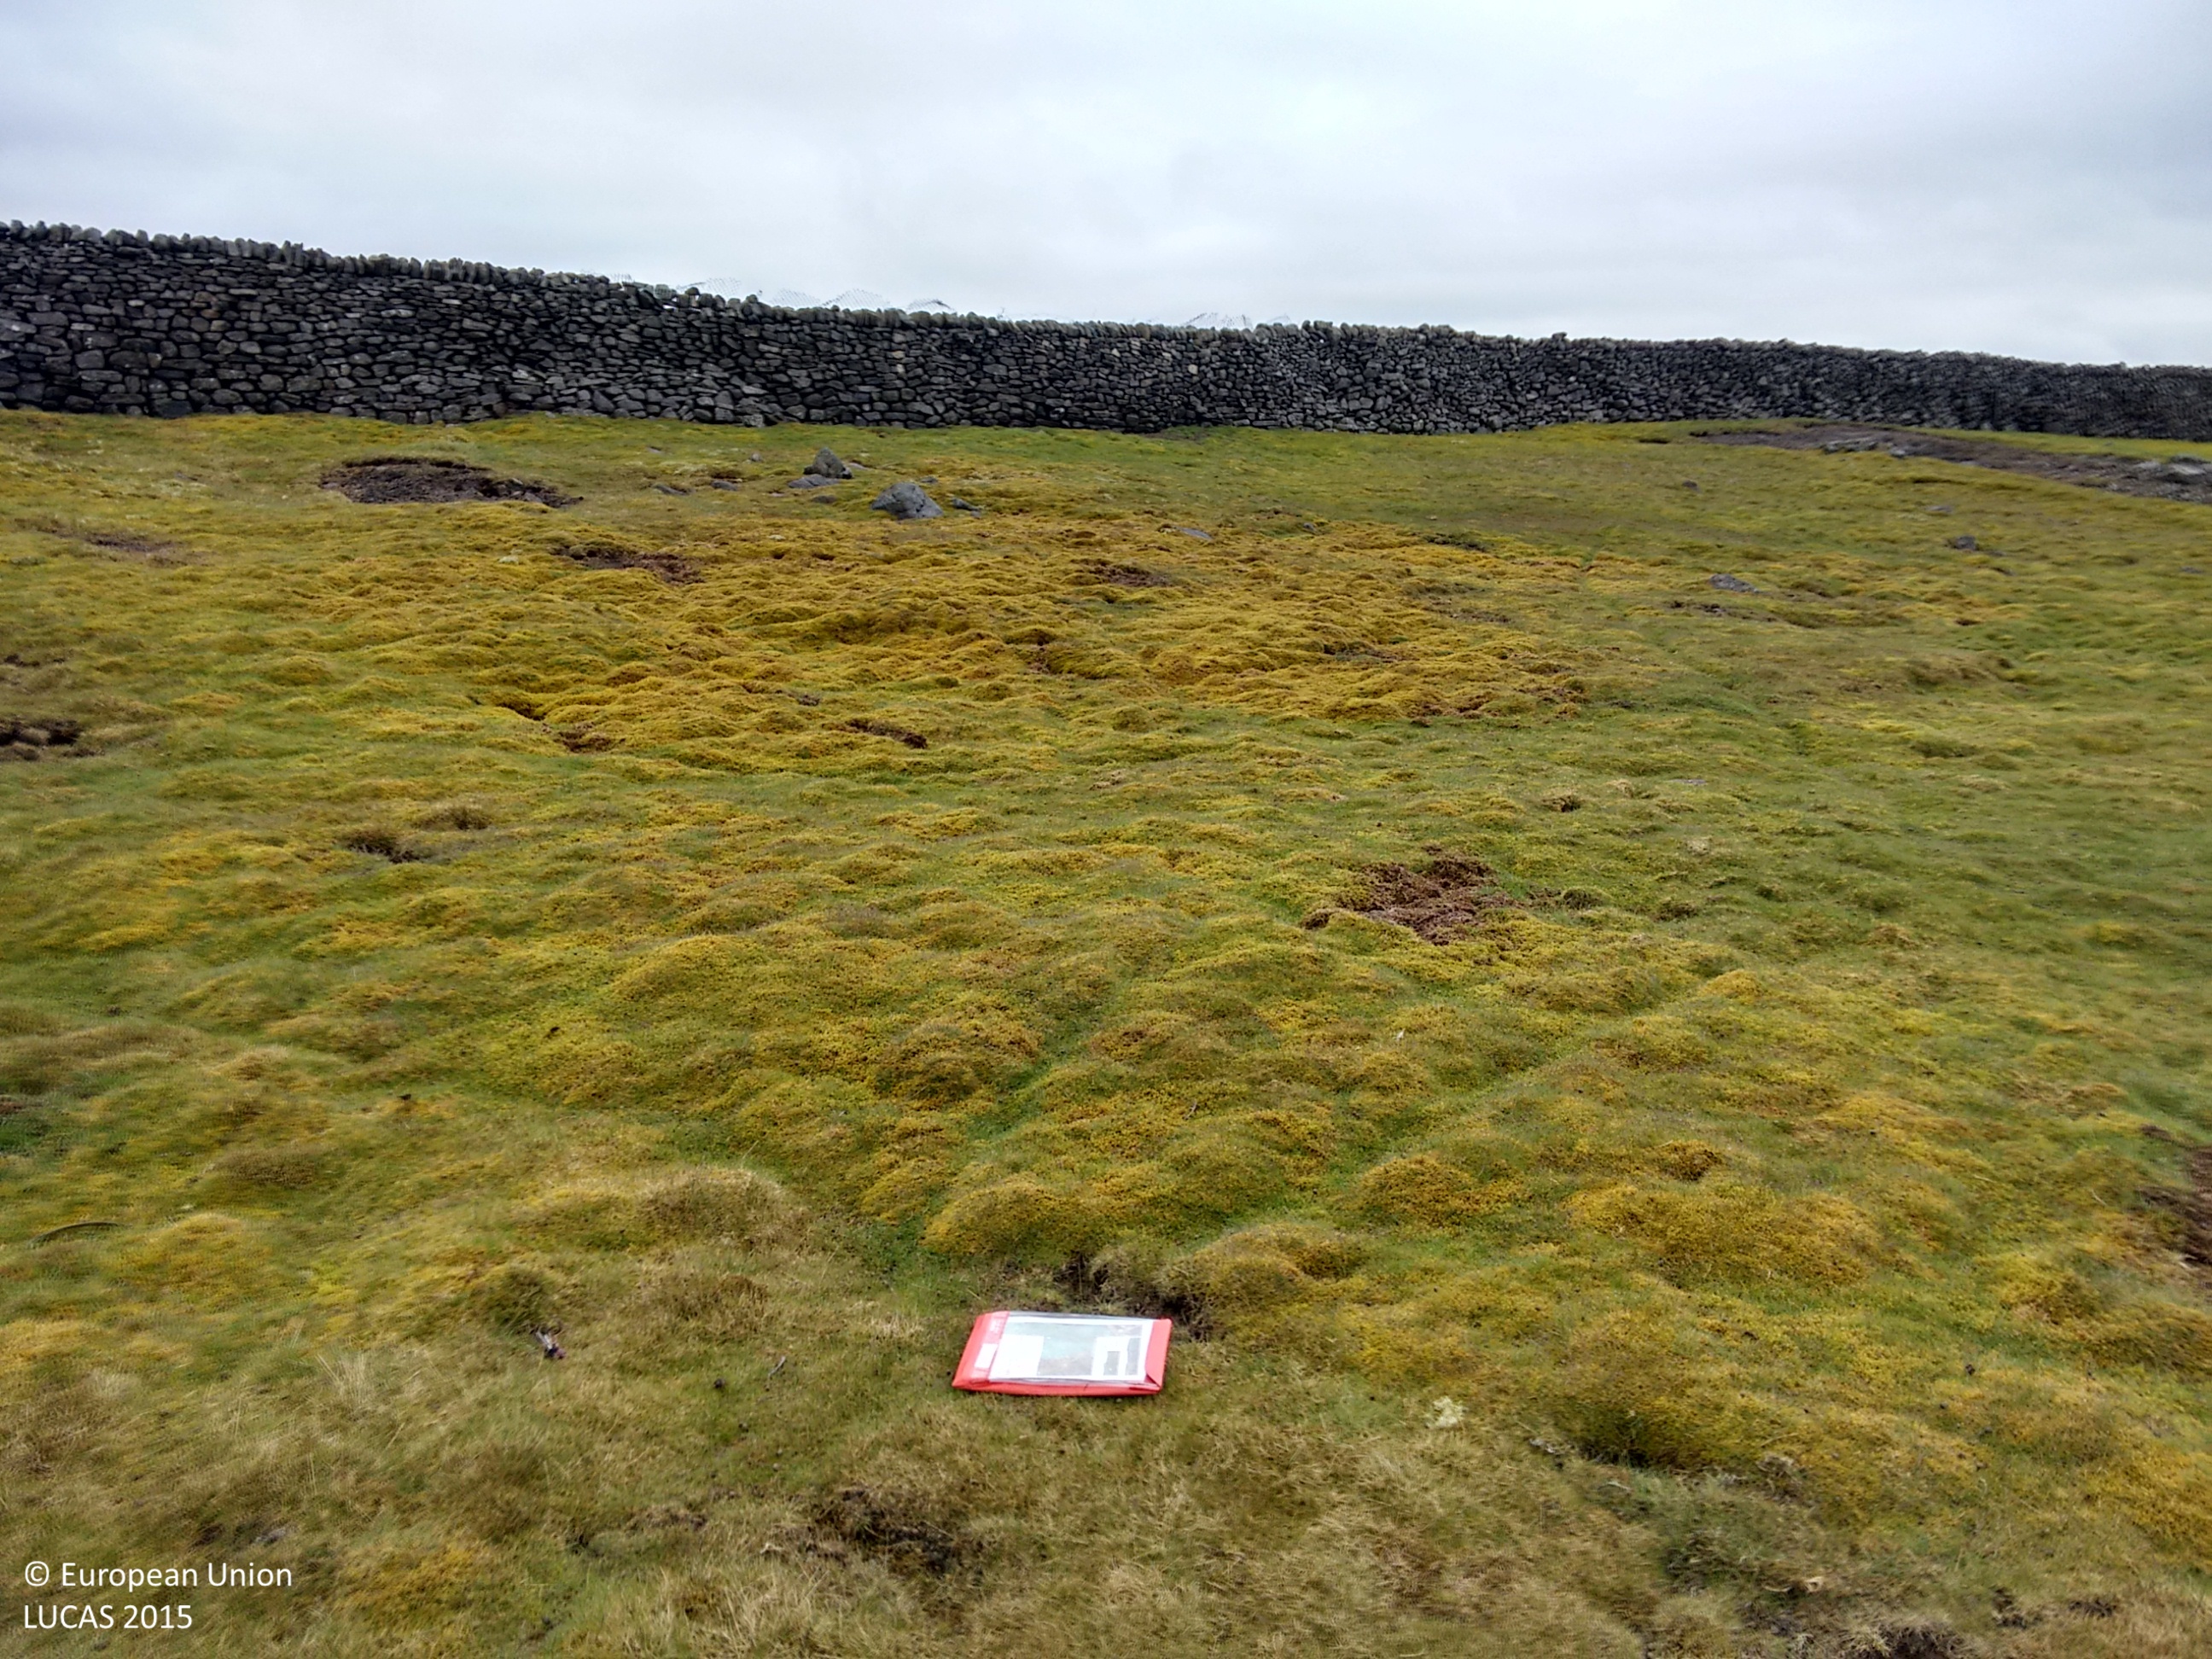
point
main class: Grassland
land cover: Grassland without tree/shrub cover
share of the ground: > 75 %
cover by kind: herbaceous plants 100 %
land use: Agriculture (excluding fallow land and kitchen gardens)
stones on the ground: < 10 %
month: June
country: GB
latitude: 54.0970
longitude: -1.9679
